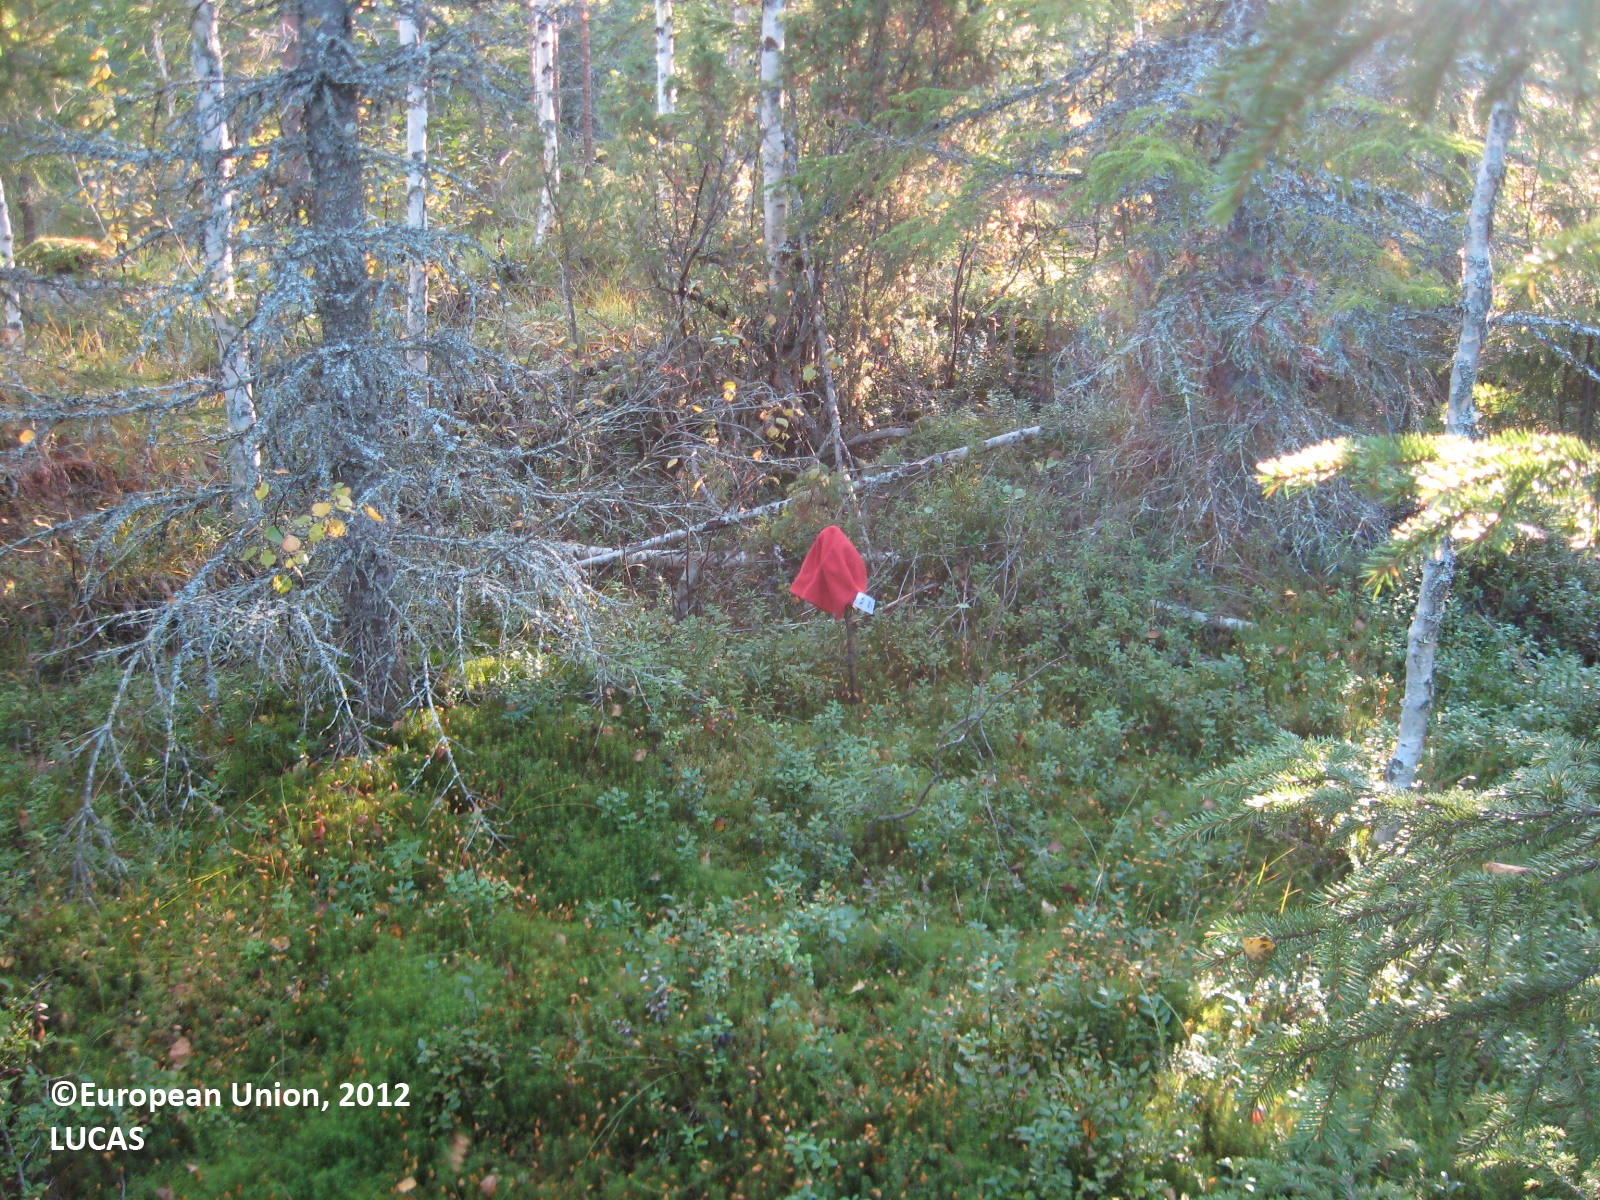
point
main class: Woodland
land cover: Spruce dominated mixed woodland
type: boreal forest
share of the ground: > 75 %
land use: Forestry
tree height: > 5 m
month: August
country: FI
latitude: 63.8567
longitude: 29.8248
